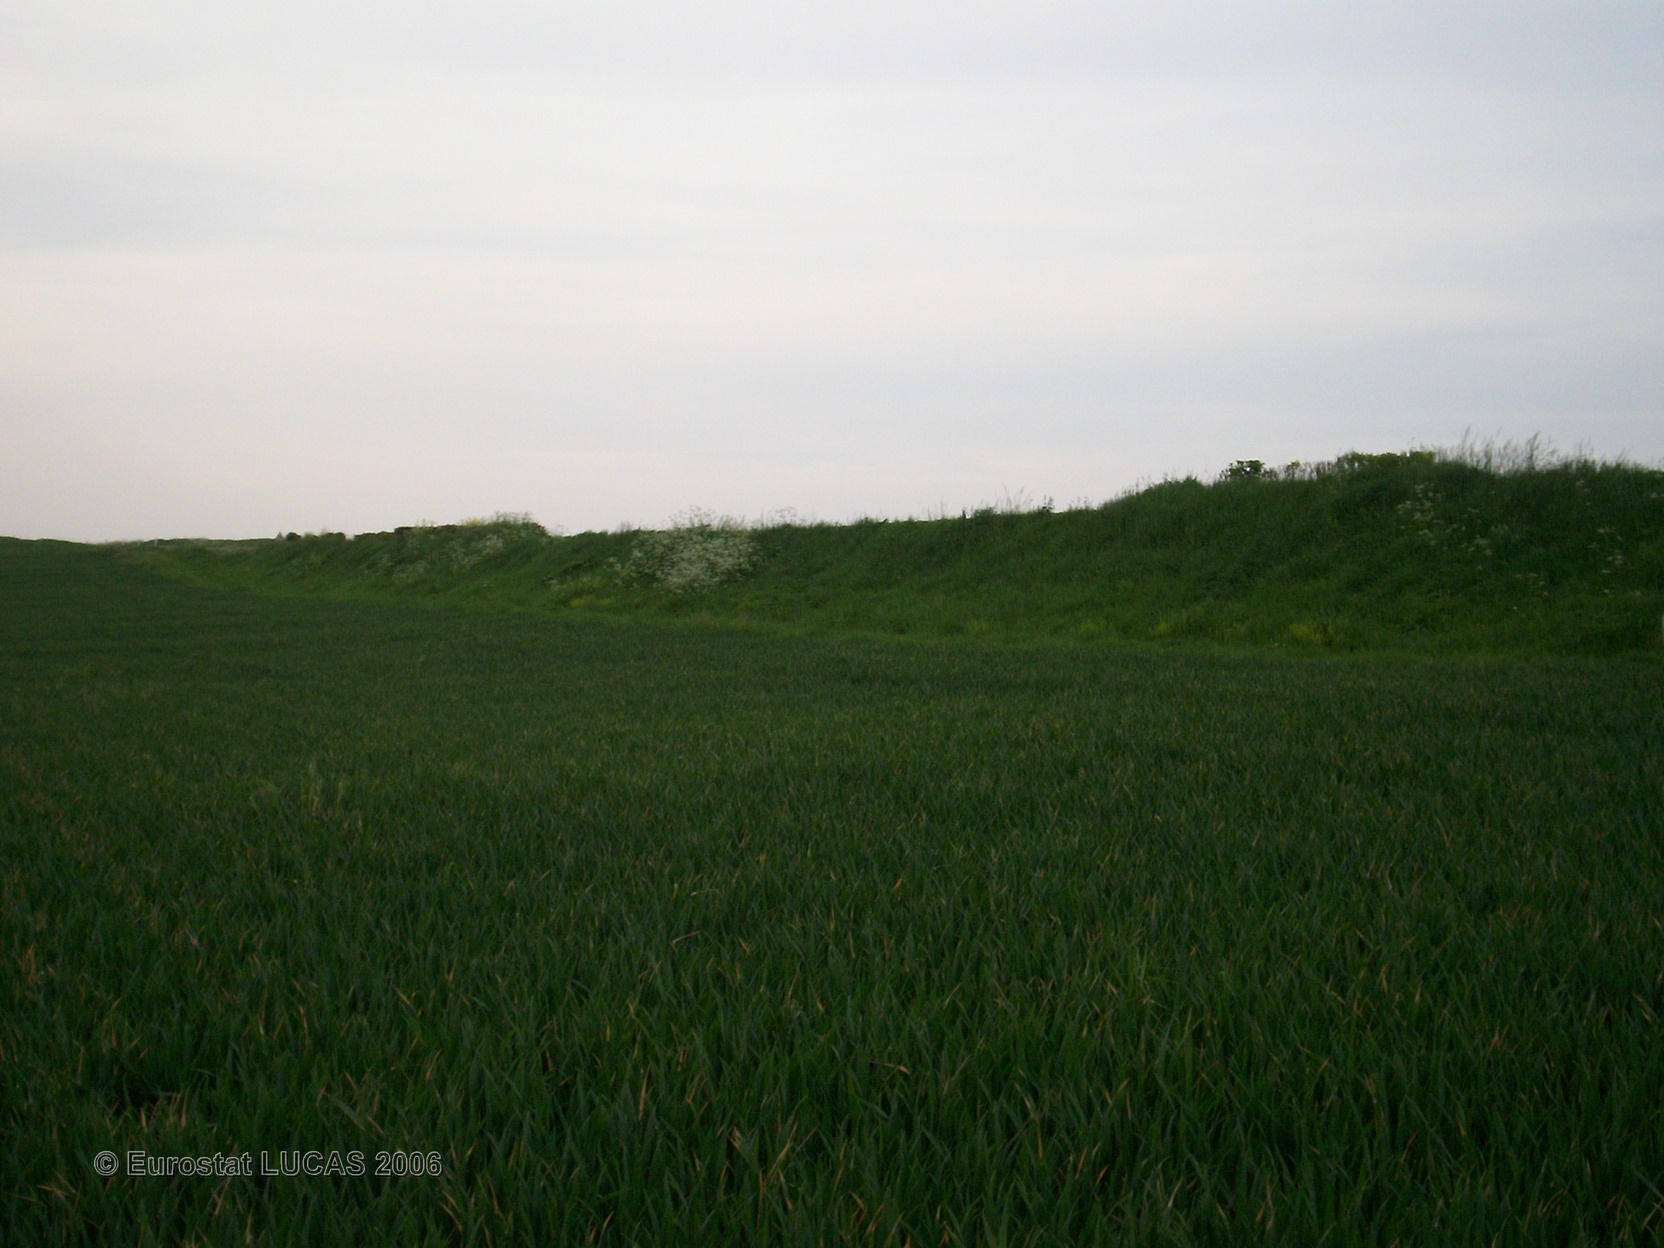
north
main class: Cropland
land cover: Common wheat
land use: Agriculture (excluding fallow land and kitchen gardens)
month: May
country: FR
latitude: 49.5377
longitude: 4.3162
